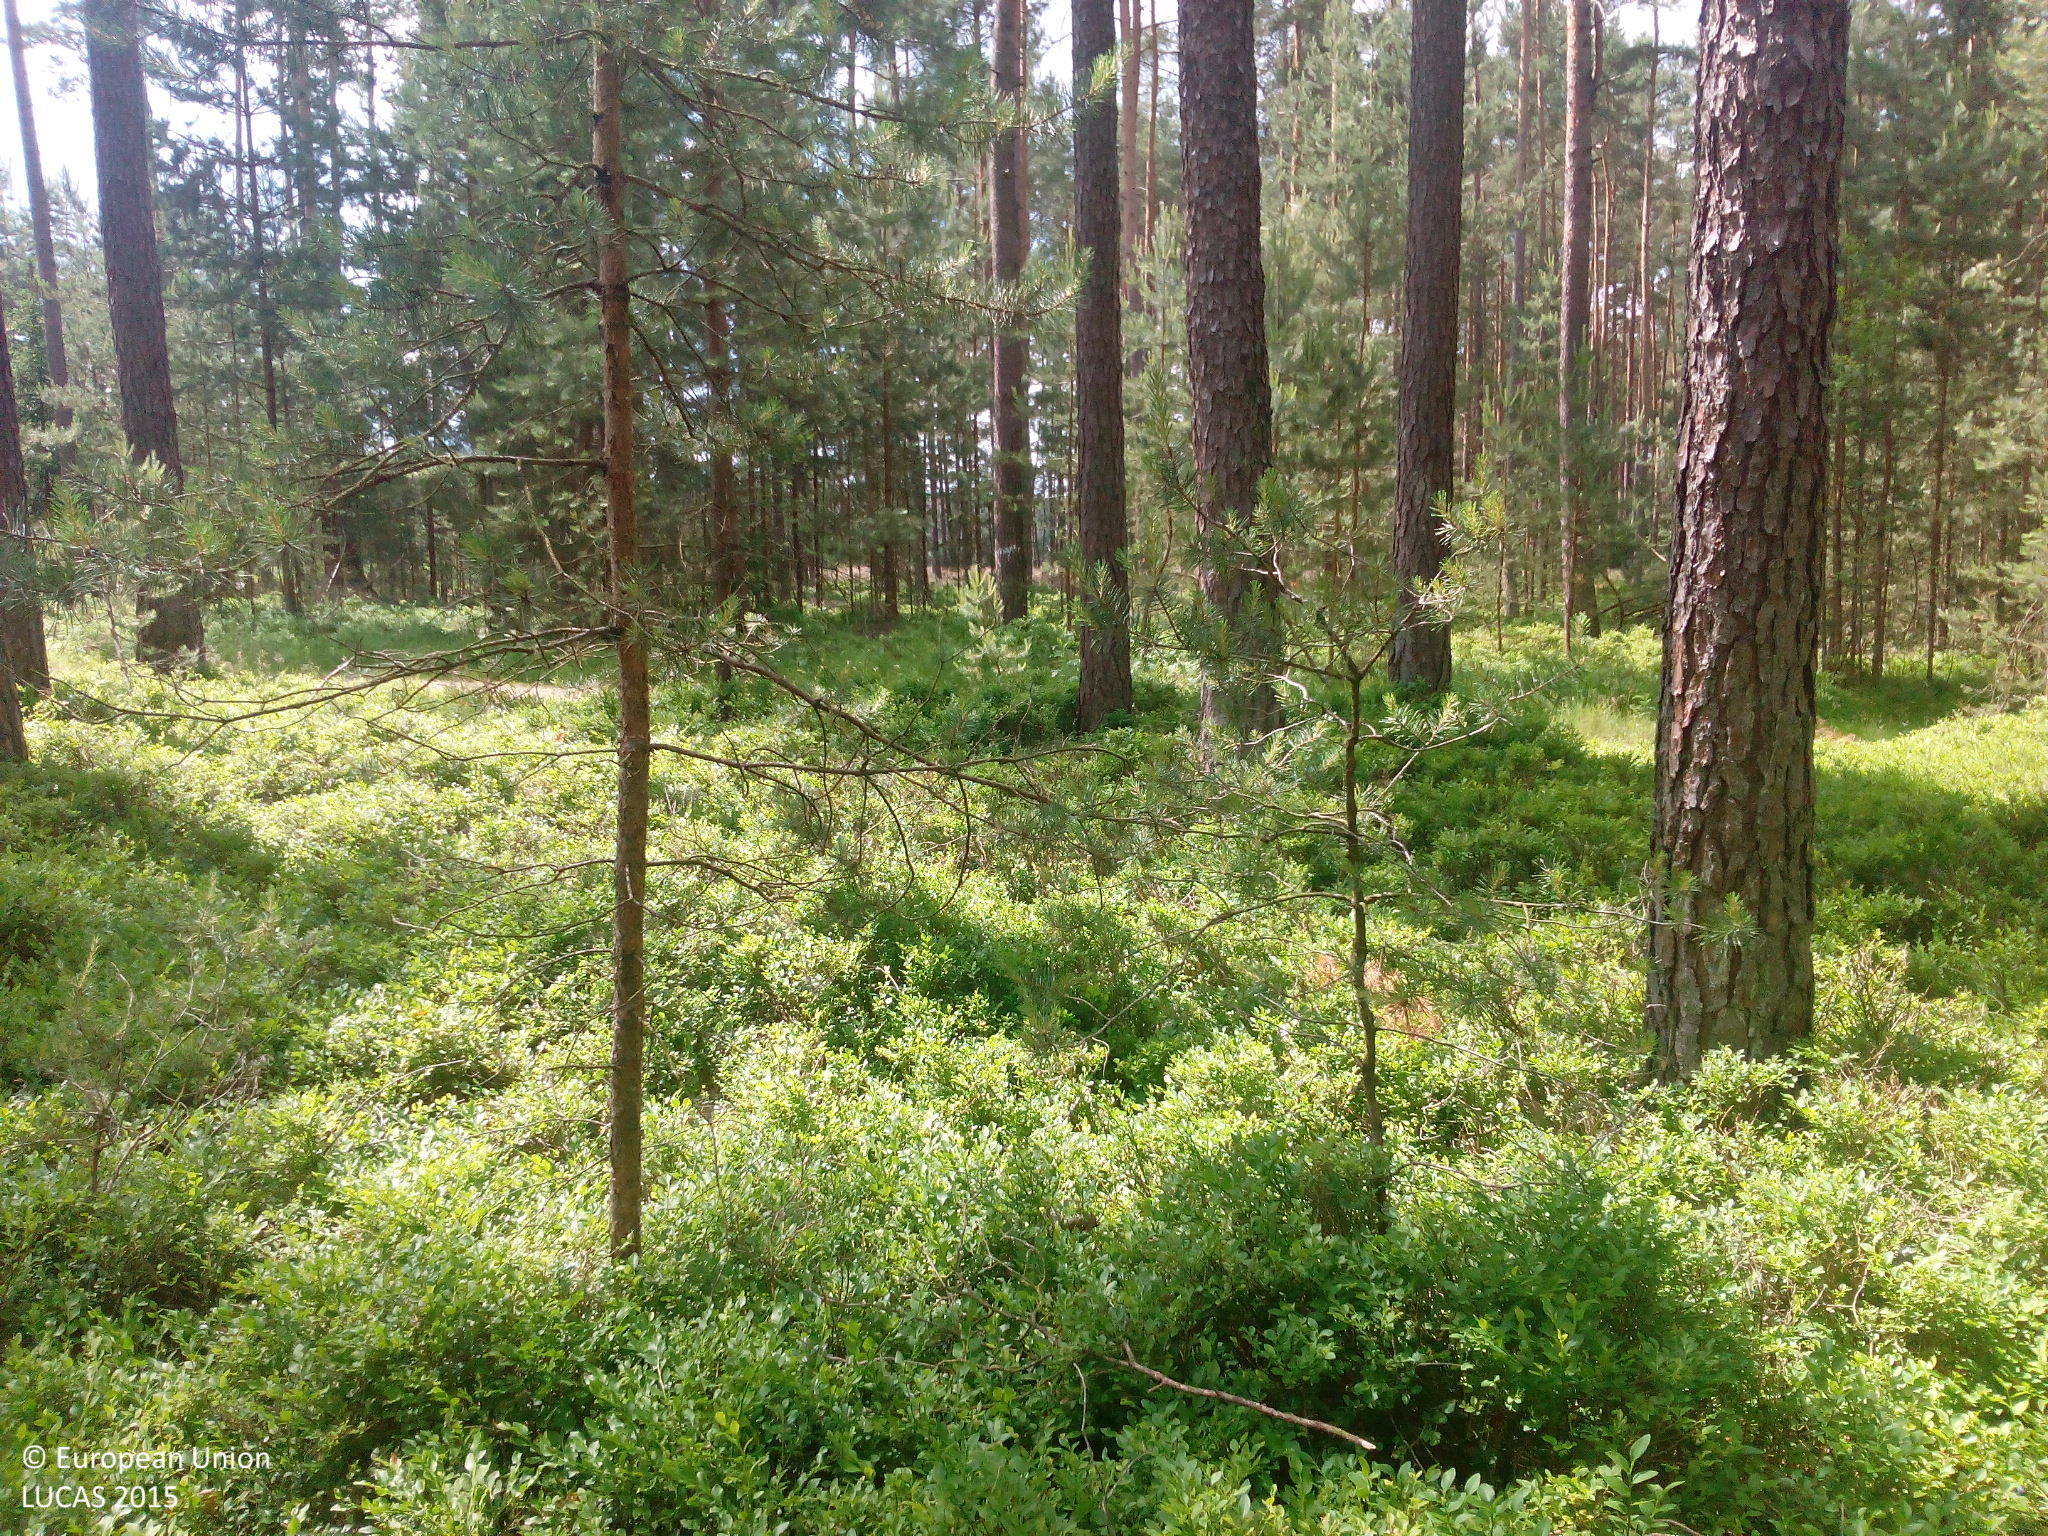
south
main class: Woodland
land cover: Pine dominated coniferous woodland
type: hemiboreal forest and nemoral coniferous forest and mixed broadleaved-coniferous forest
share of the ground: > 75 %
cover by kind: coniferous forest trees 75 %, shrubs 20 %, herbaceous plants 5 %
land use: Forestry
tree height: > 5 m
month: June
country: DE
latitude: 49.2453
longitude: 10.9200
